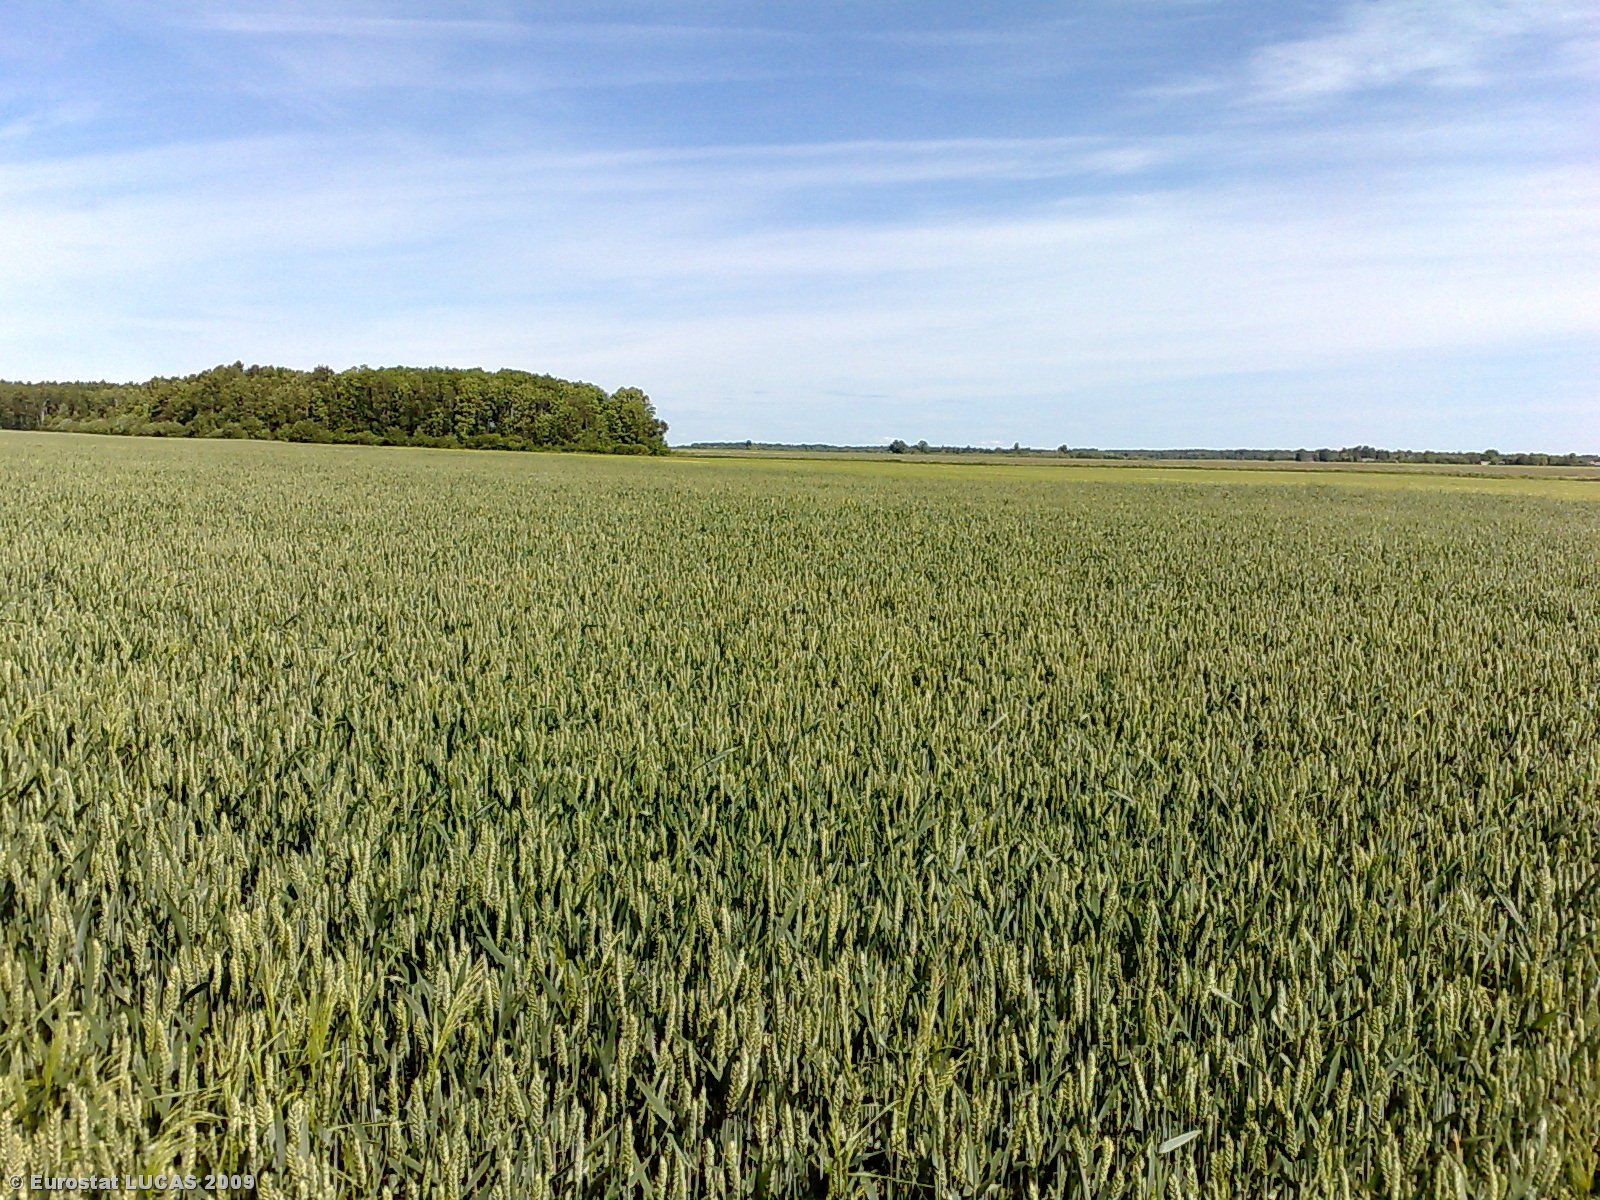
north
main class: Cropland
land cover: Common wheat
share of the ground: > 75 %
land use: Agriculture (excluding fallow land and kitchen gardens)
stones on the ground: < 10 %
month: June
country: LT
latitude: 55.8536
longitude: 24.0015
